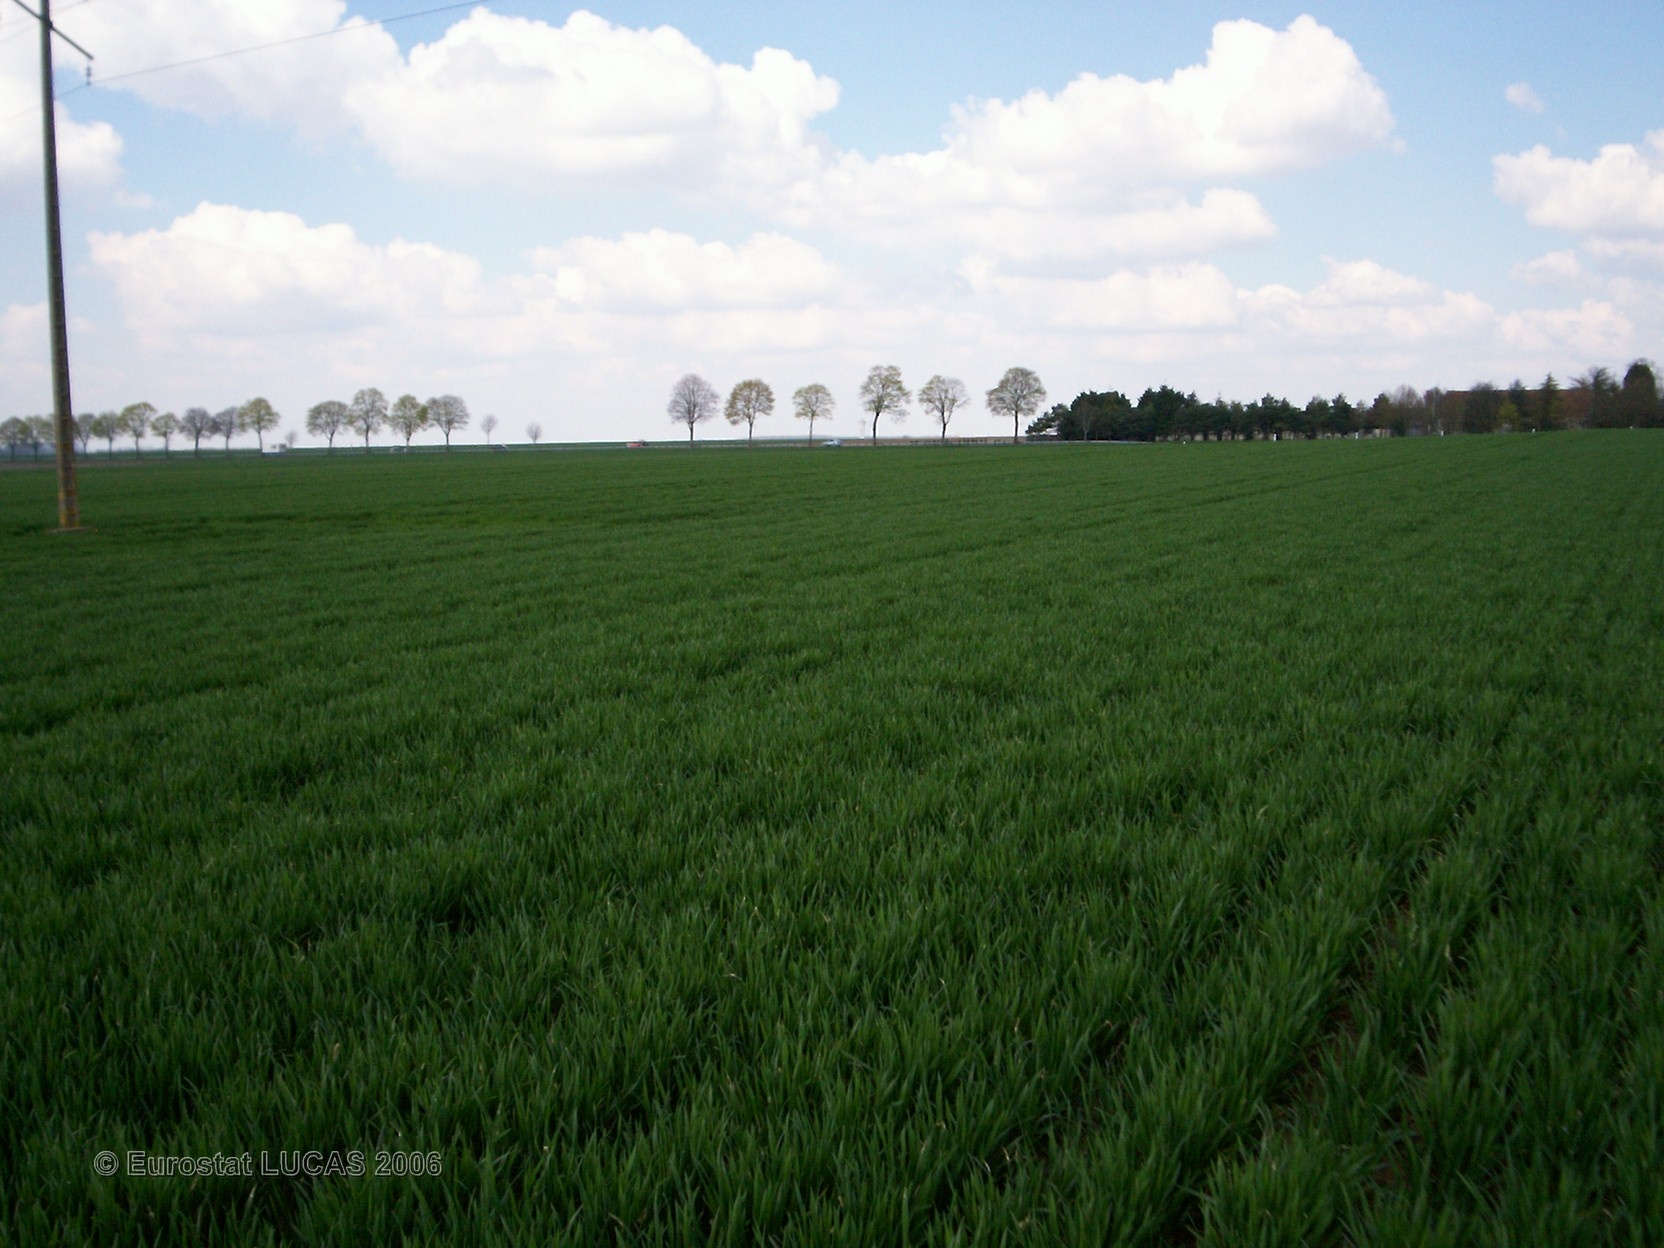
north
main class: Cropland
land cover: Common wheat
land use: Agriculture (excluding fallow land and kitchen gardens)
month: April
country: FR
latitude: 47.1958
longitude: 0.9151
